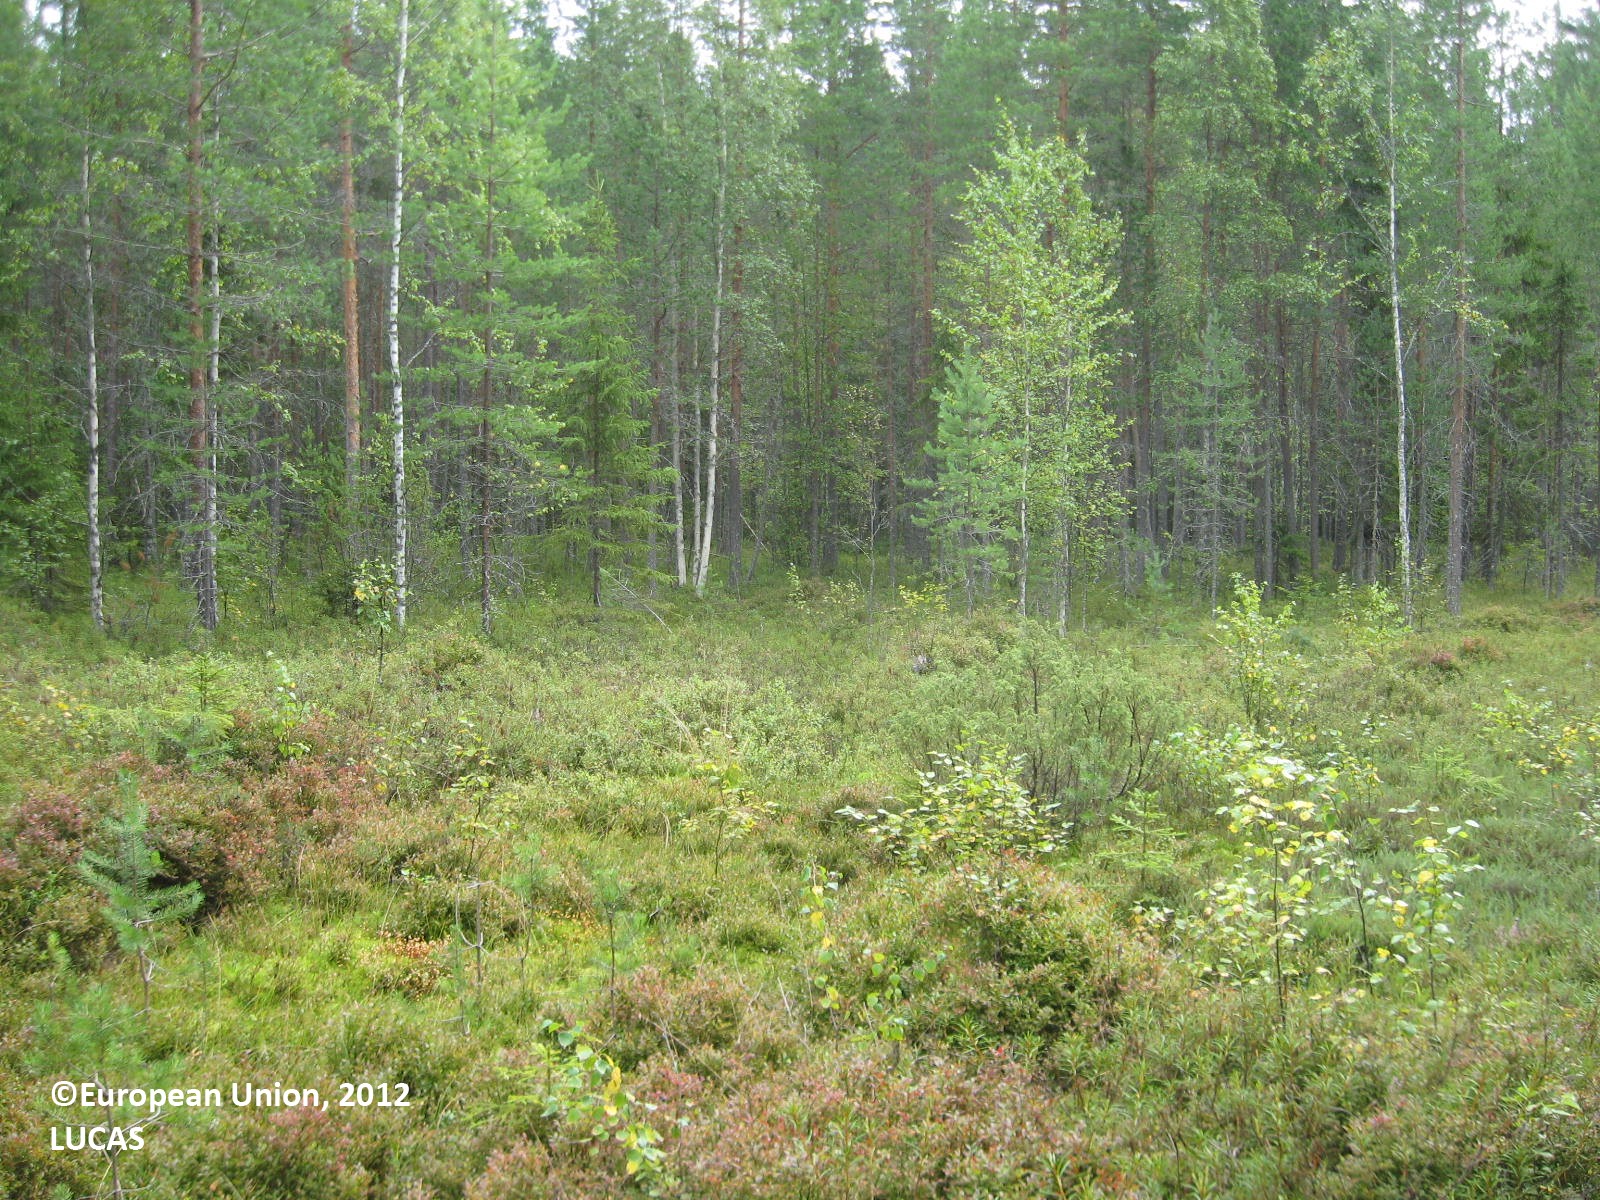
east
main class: Shrubland
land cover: Shrubland with sparse tree cover
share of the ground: > 75 %
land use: Energy production
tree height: < 5 m
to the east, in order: Shrubland with sparse tree cover; Electric lines; Shrubland with sparse tree cover; Pine dominated coniferous woodland; Ditches and canals; Pine dominated mixed woodland; Other coniferous woodland; Ditches and canals; Paved roads, cycling and walking lanes; Pine dominated coniferous woodland
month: August
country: FI
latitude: 63.4416
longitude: 29.4092
